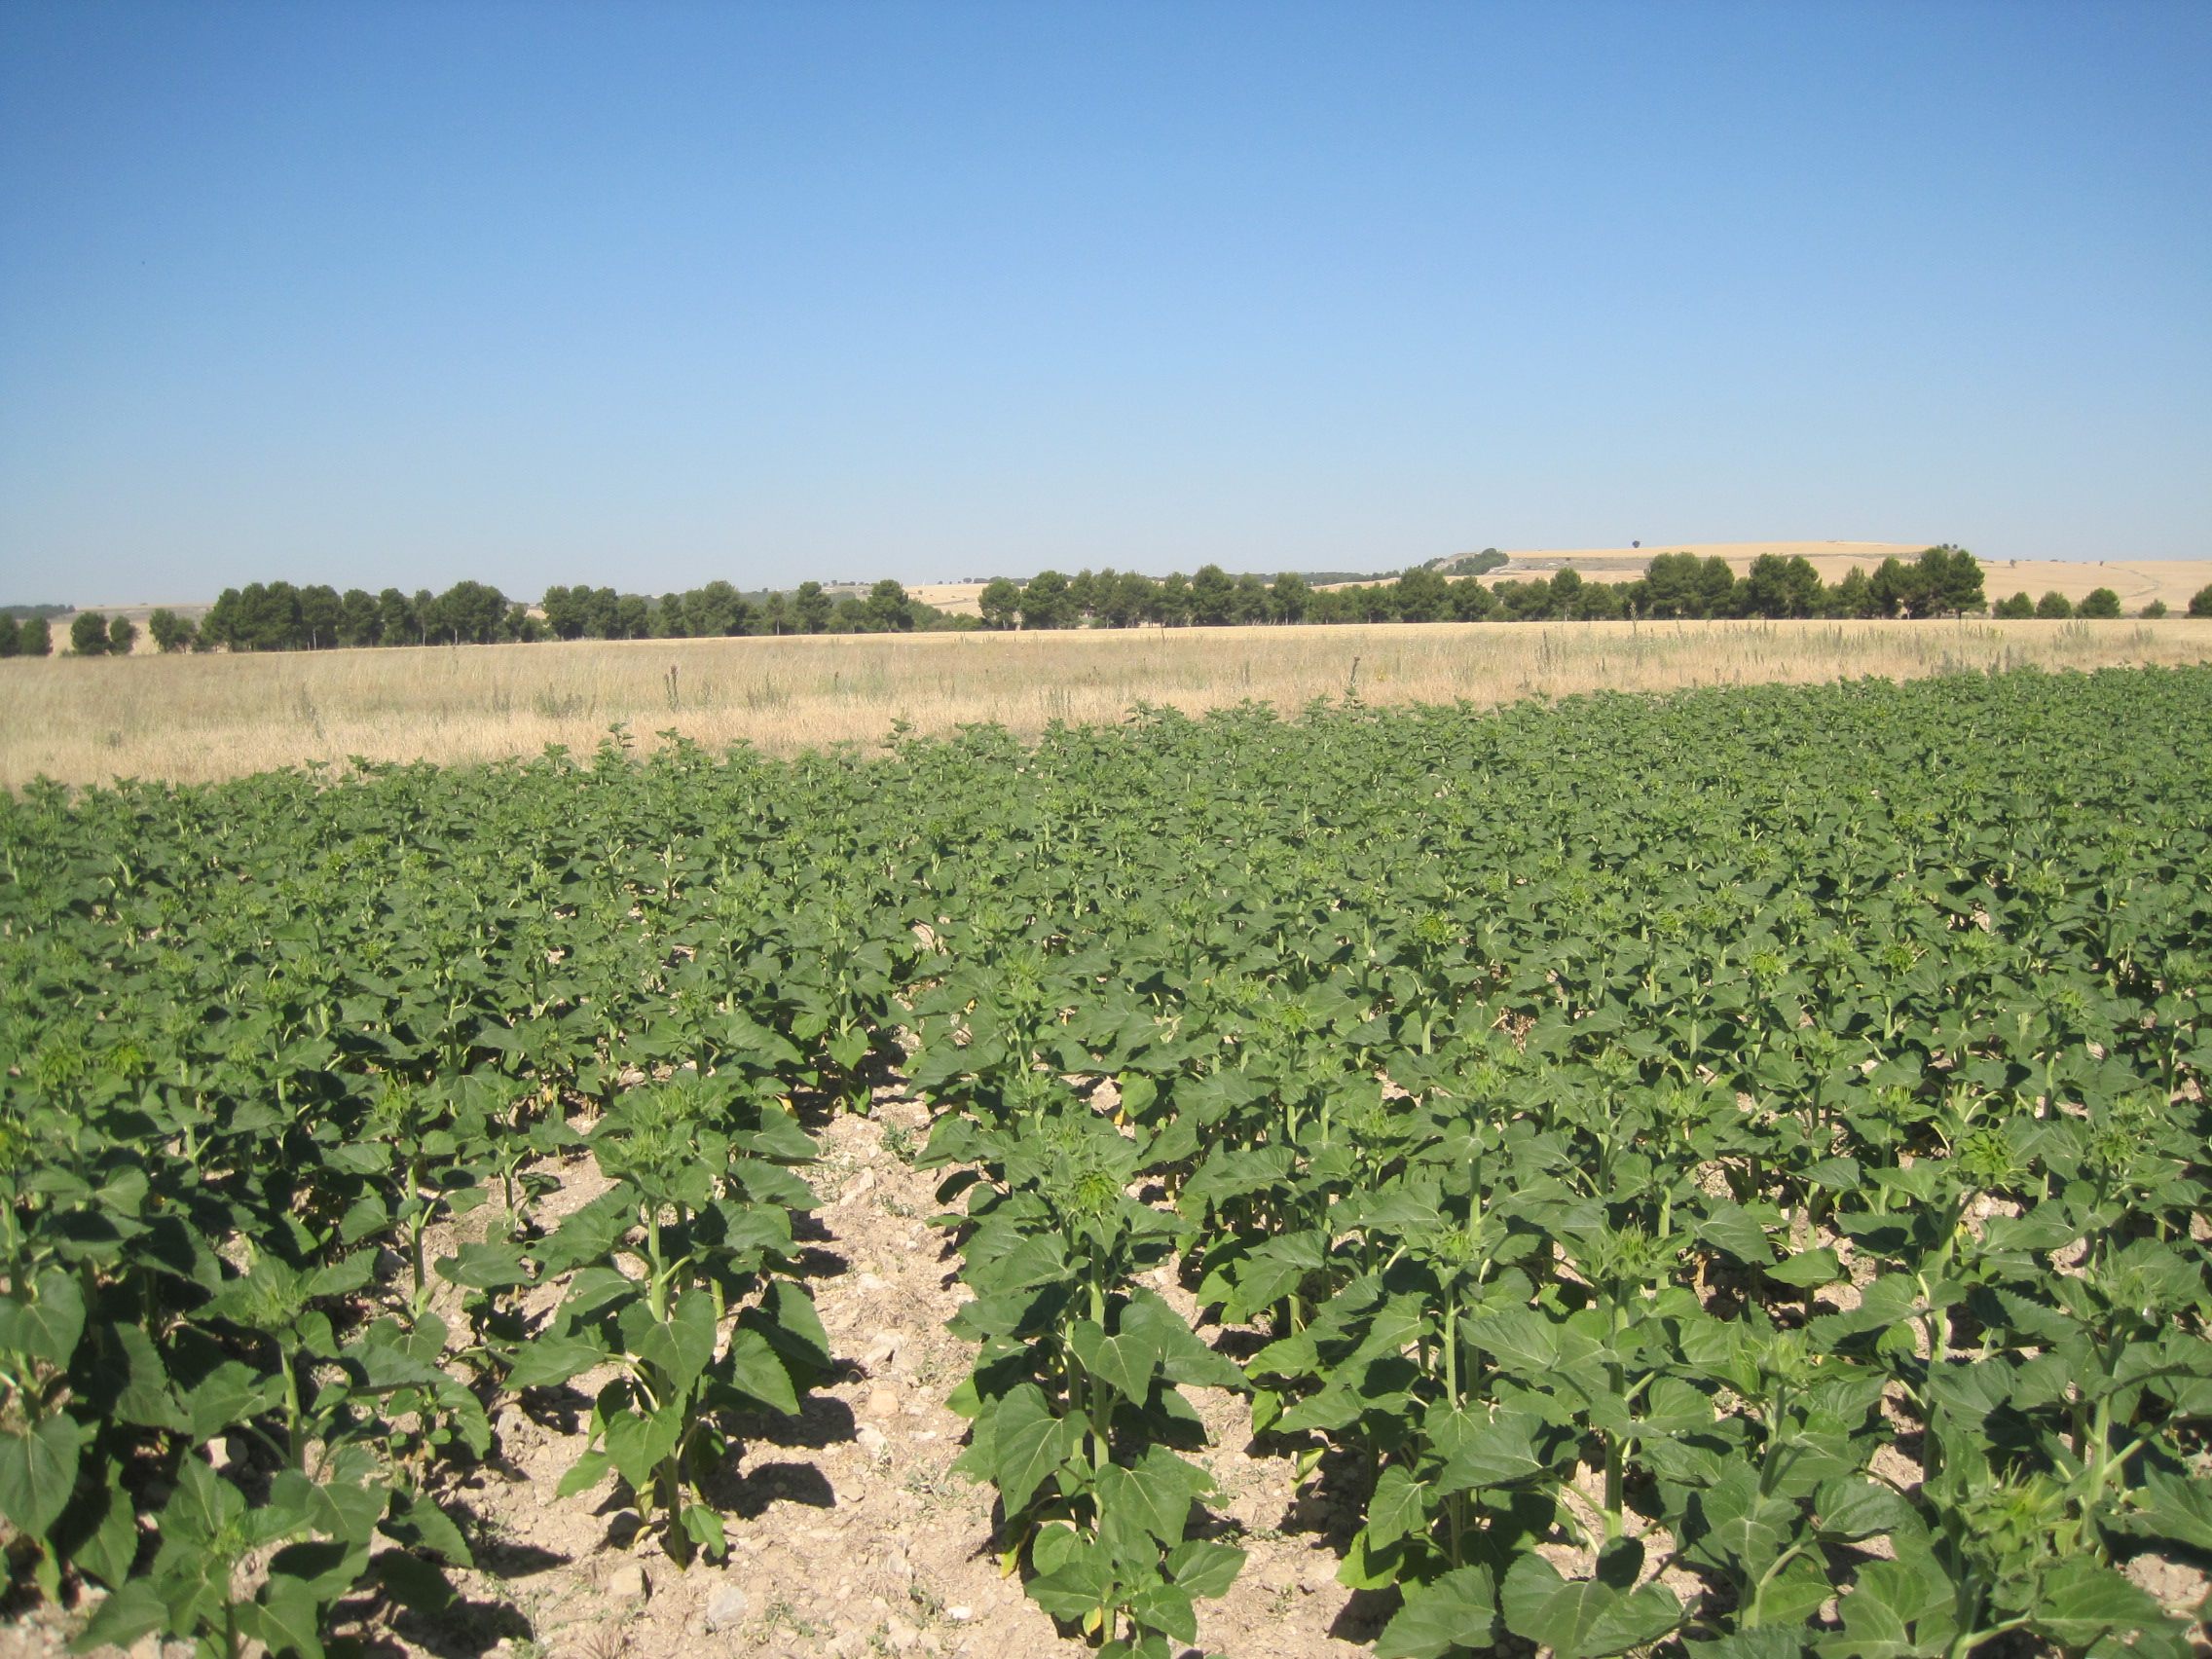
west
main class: Cropland
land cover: Sunflower
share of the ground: > 75 %
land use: Agriculture (excluding fallow land and kitchen gardens)
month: July
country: ES
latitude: 41.8383
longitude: -4.6535
